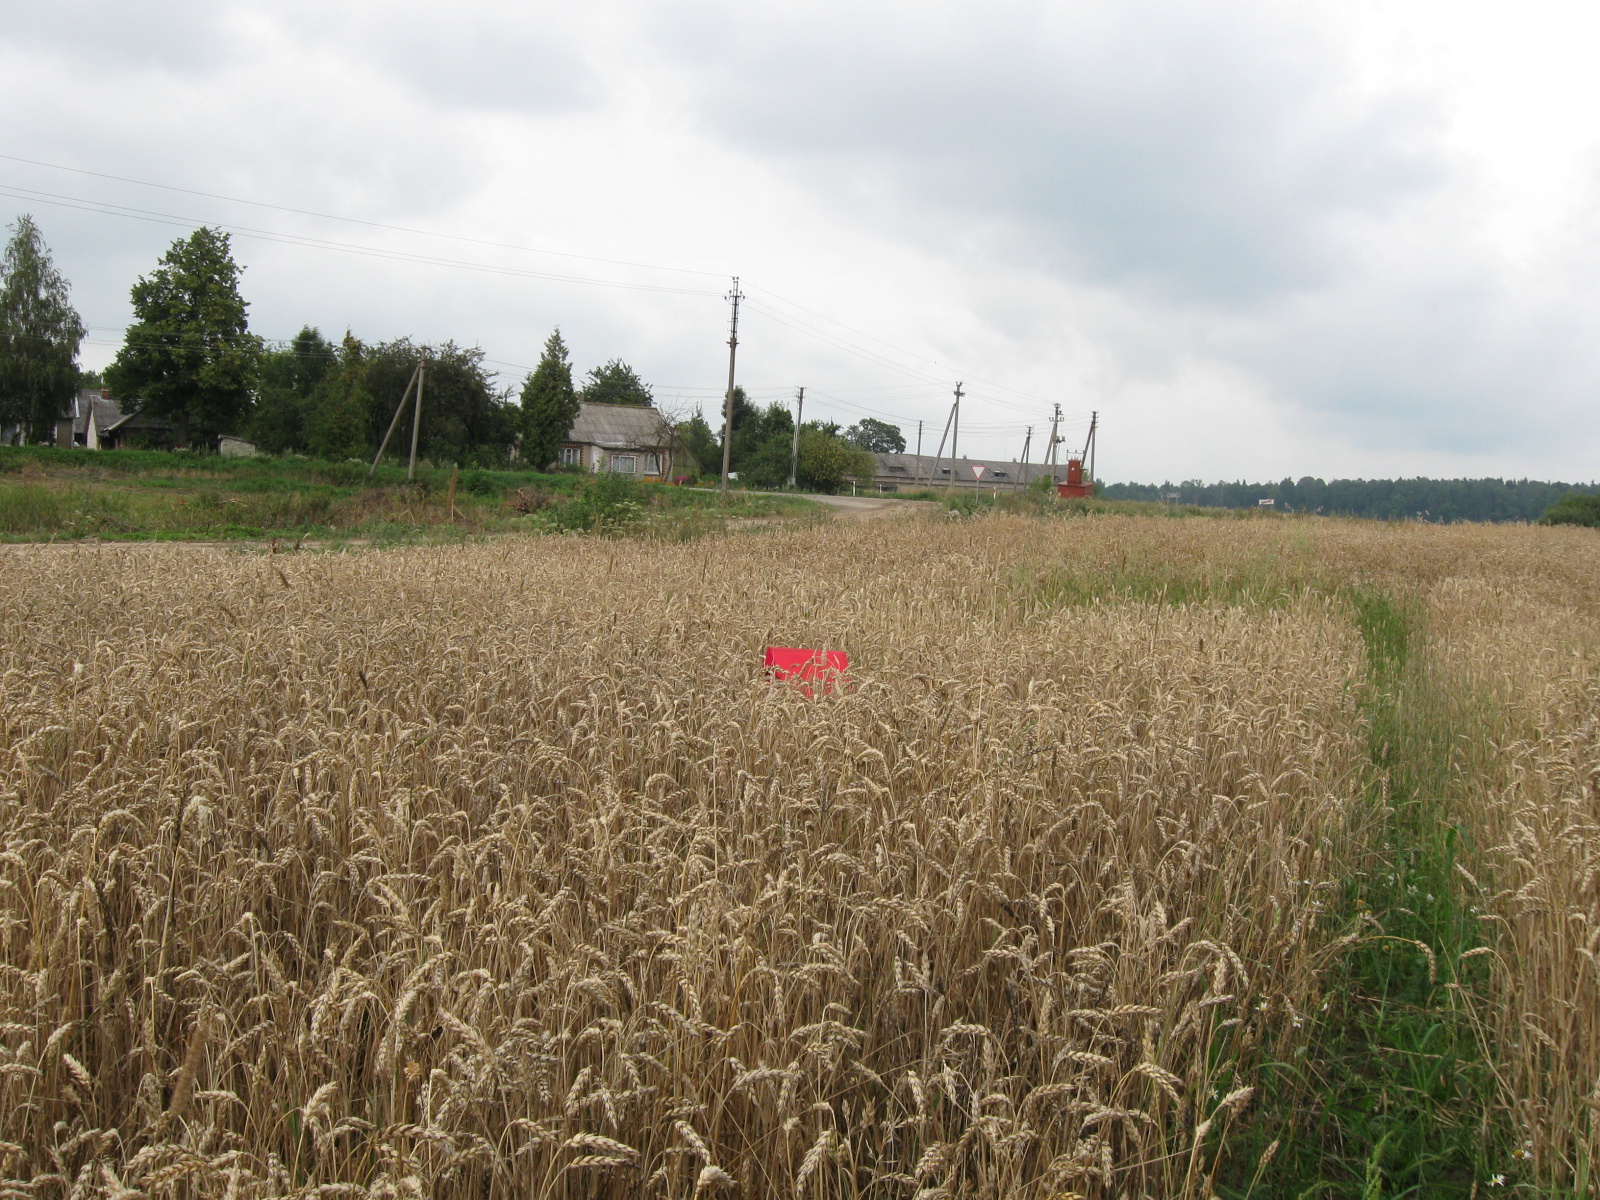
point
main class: Cropland
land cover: Common wheat
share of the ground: > 75 %
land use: Agriculture (excluding fallow land and kitchen gardens)
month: August
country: LT
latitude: 54.6465
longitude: 23.5177
